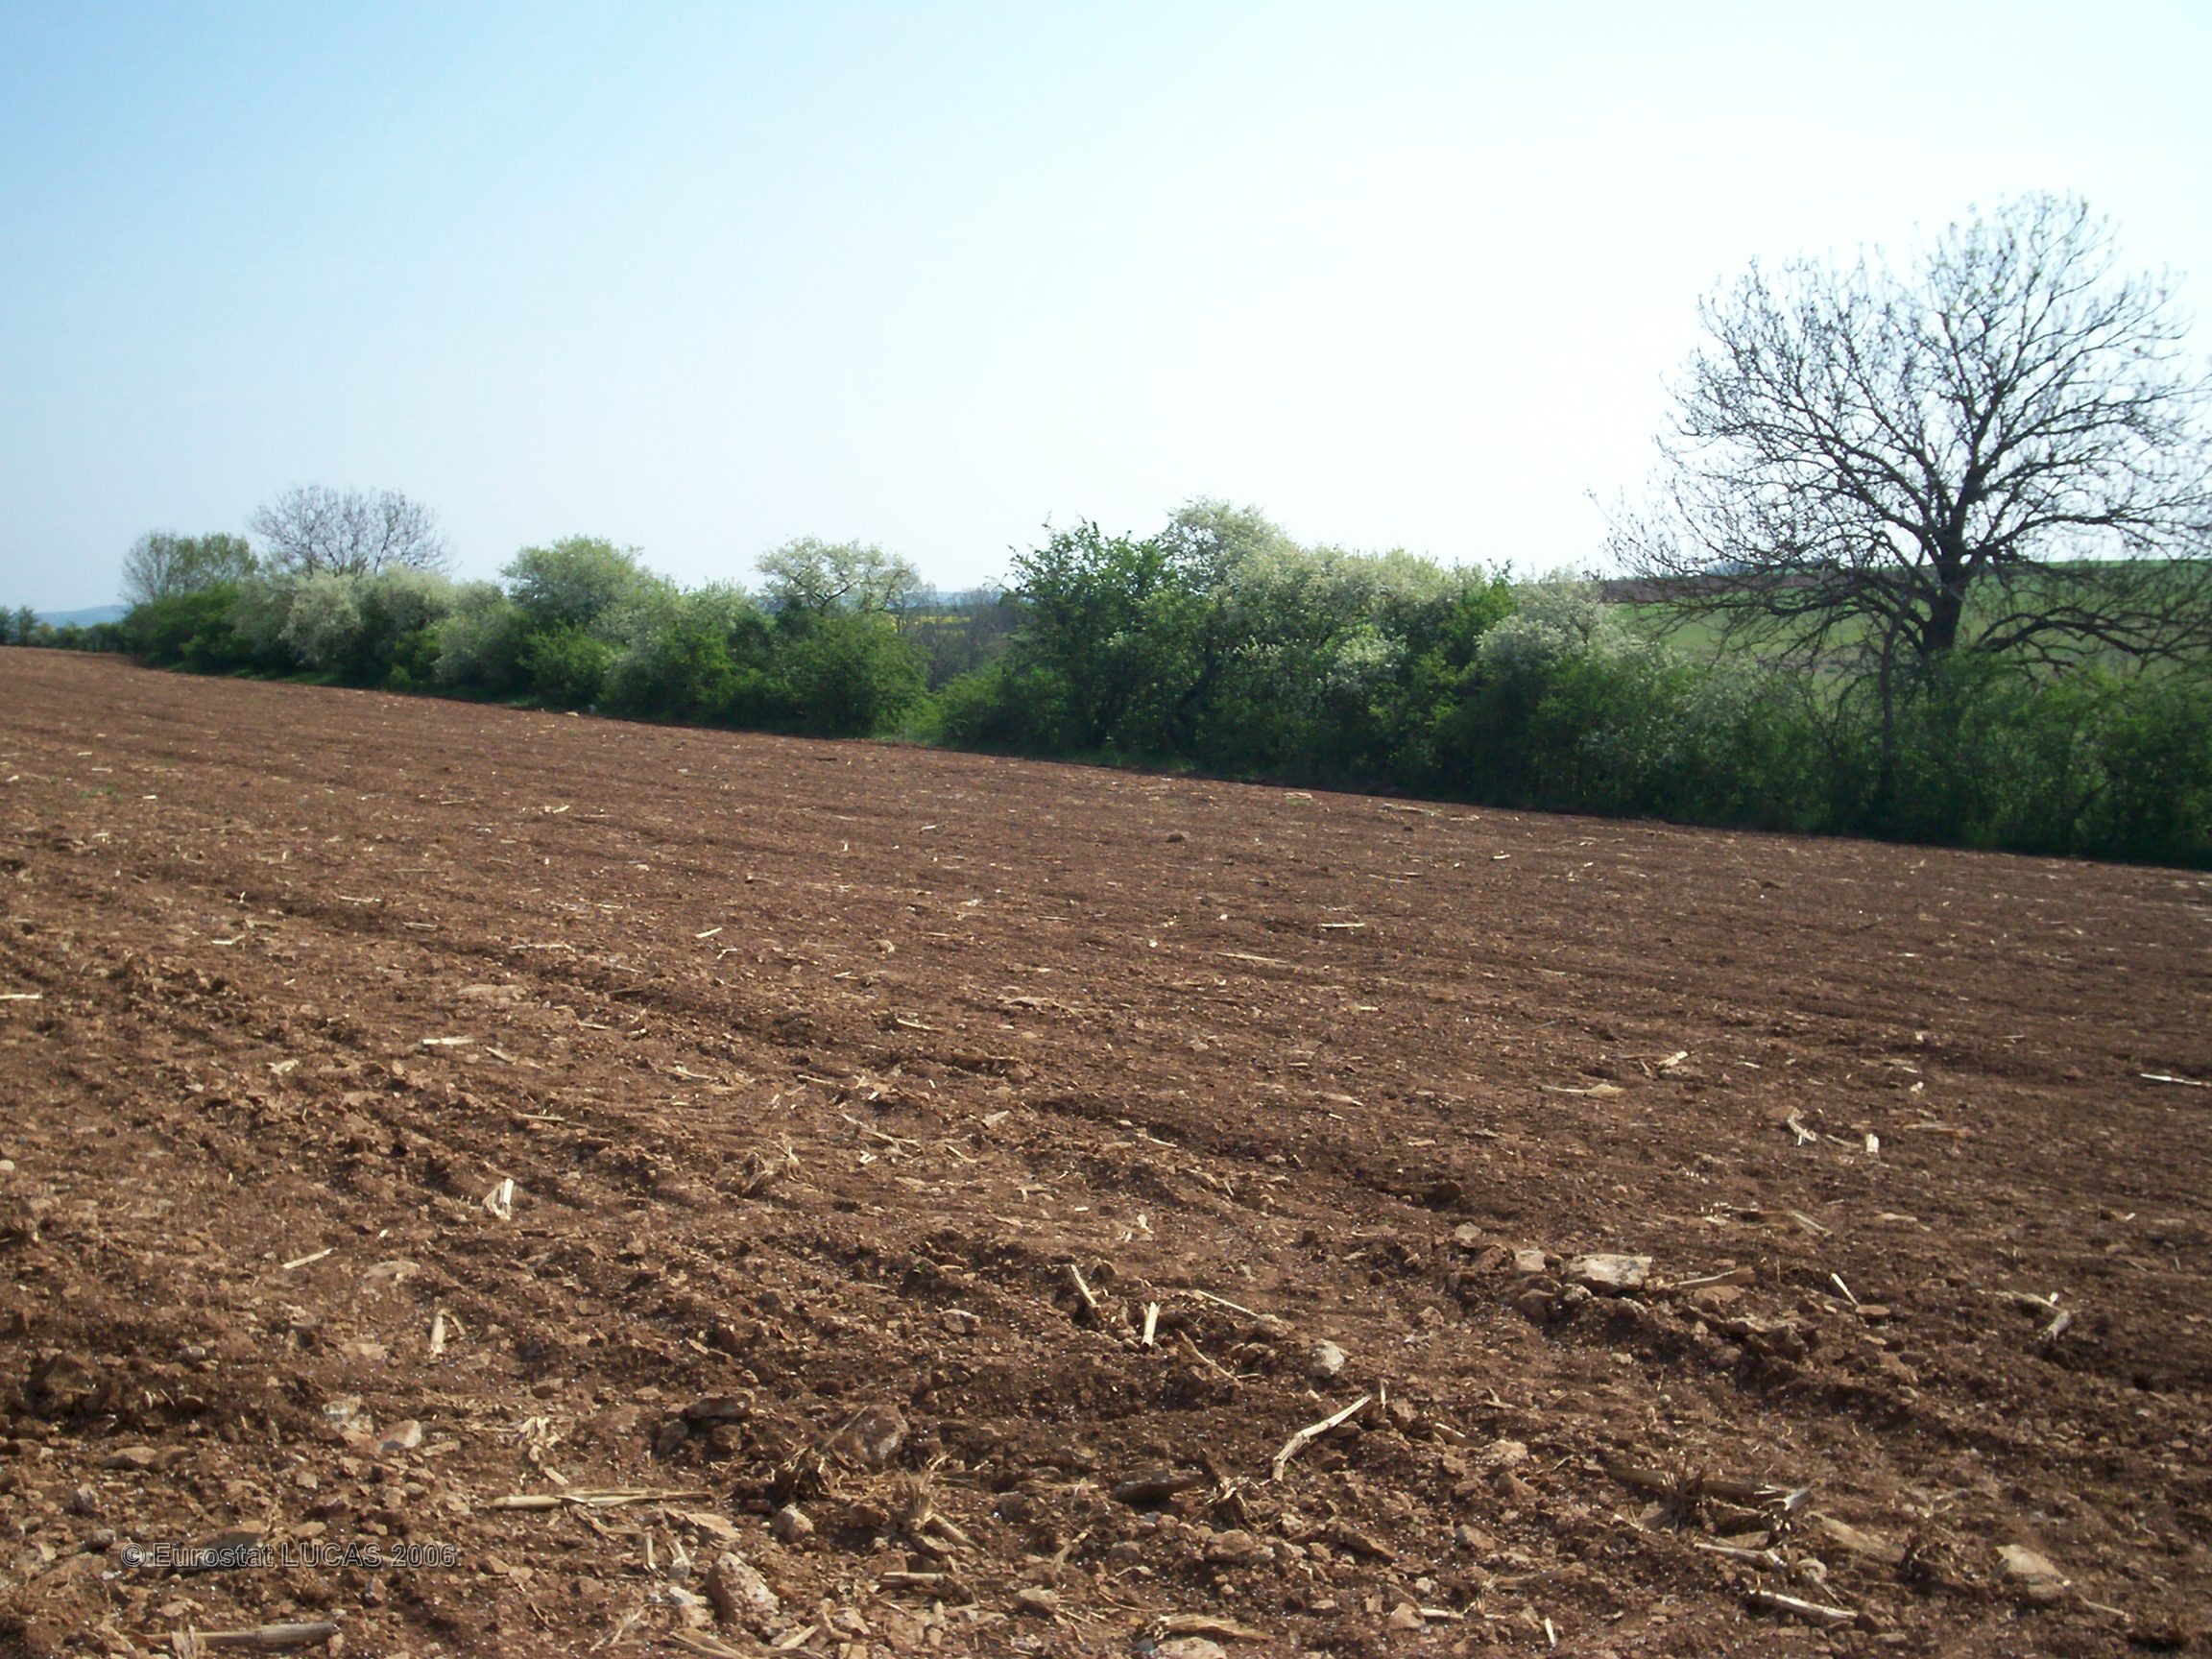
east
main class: Cropland
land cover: Maize
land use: Agriculture (excluding fallow land and kitchen gardens)
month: May
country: FR
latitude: 47.6367
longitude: 5.3020
